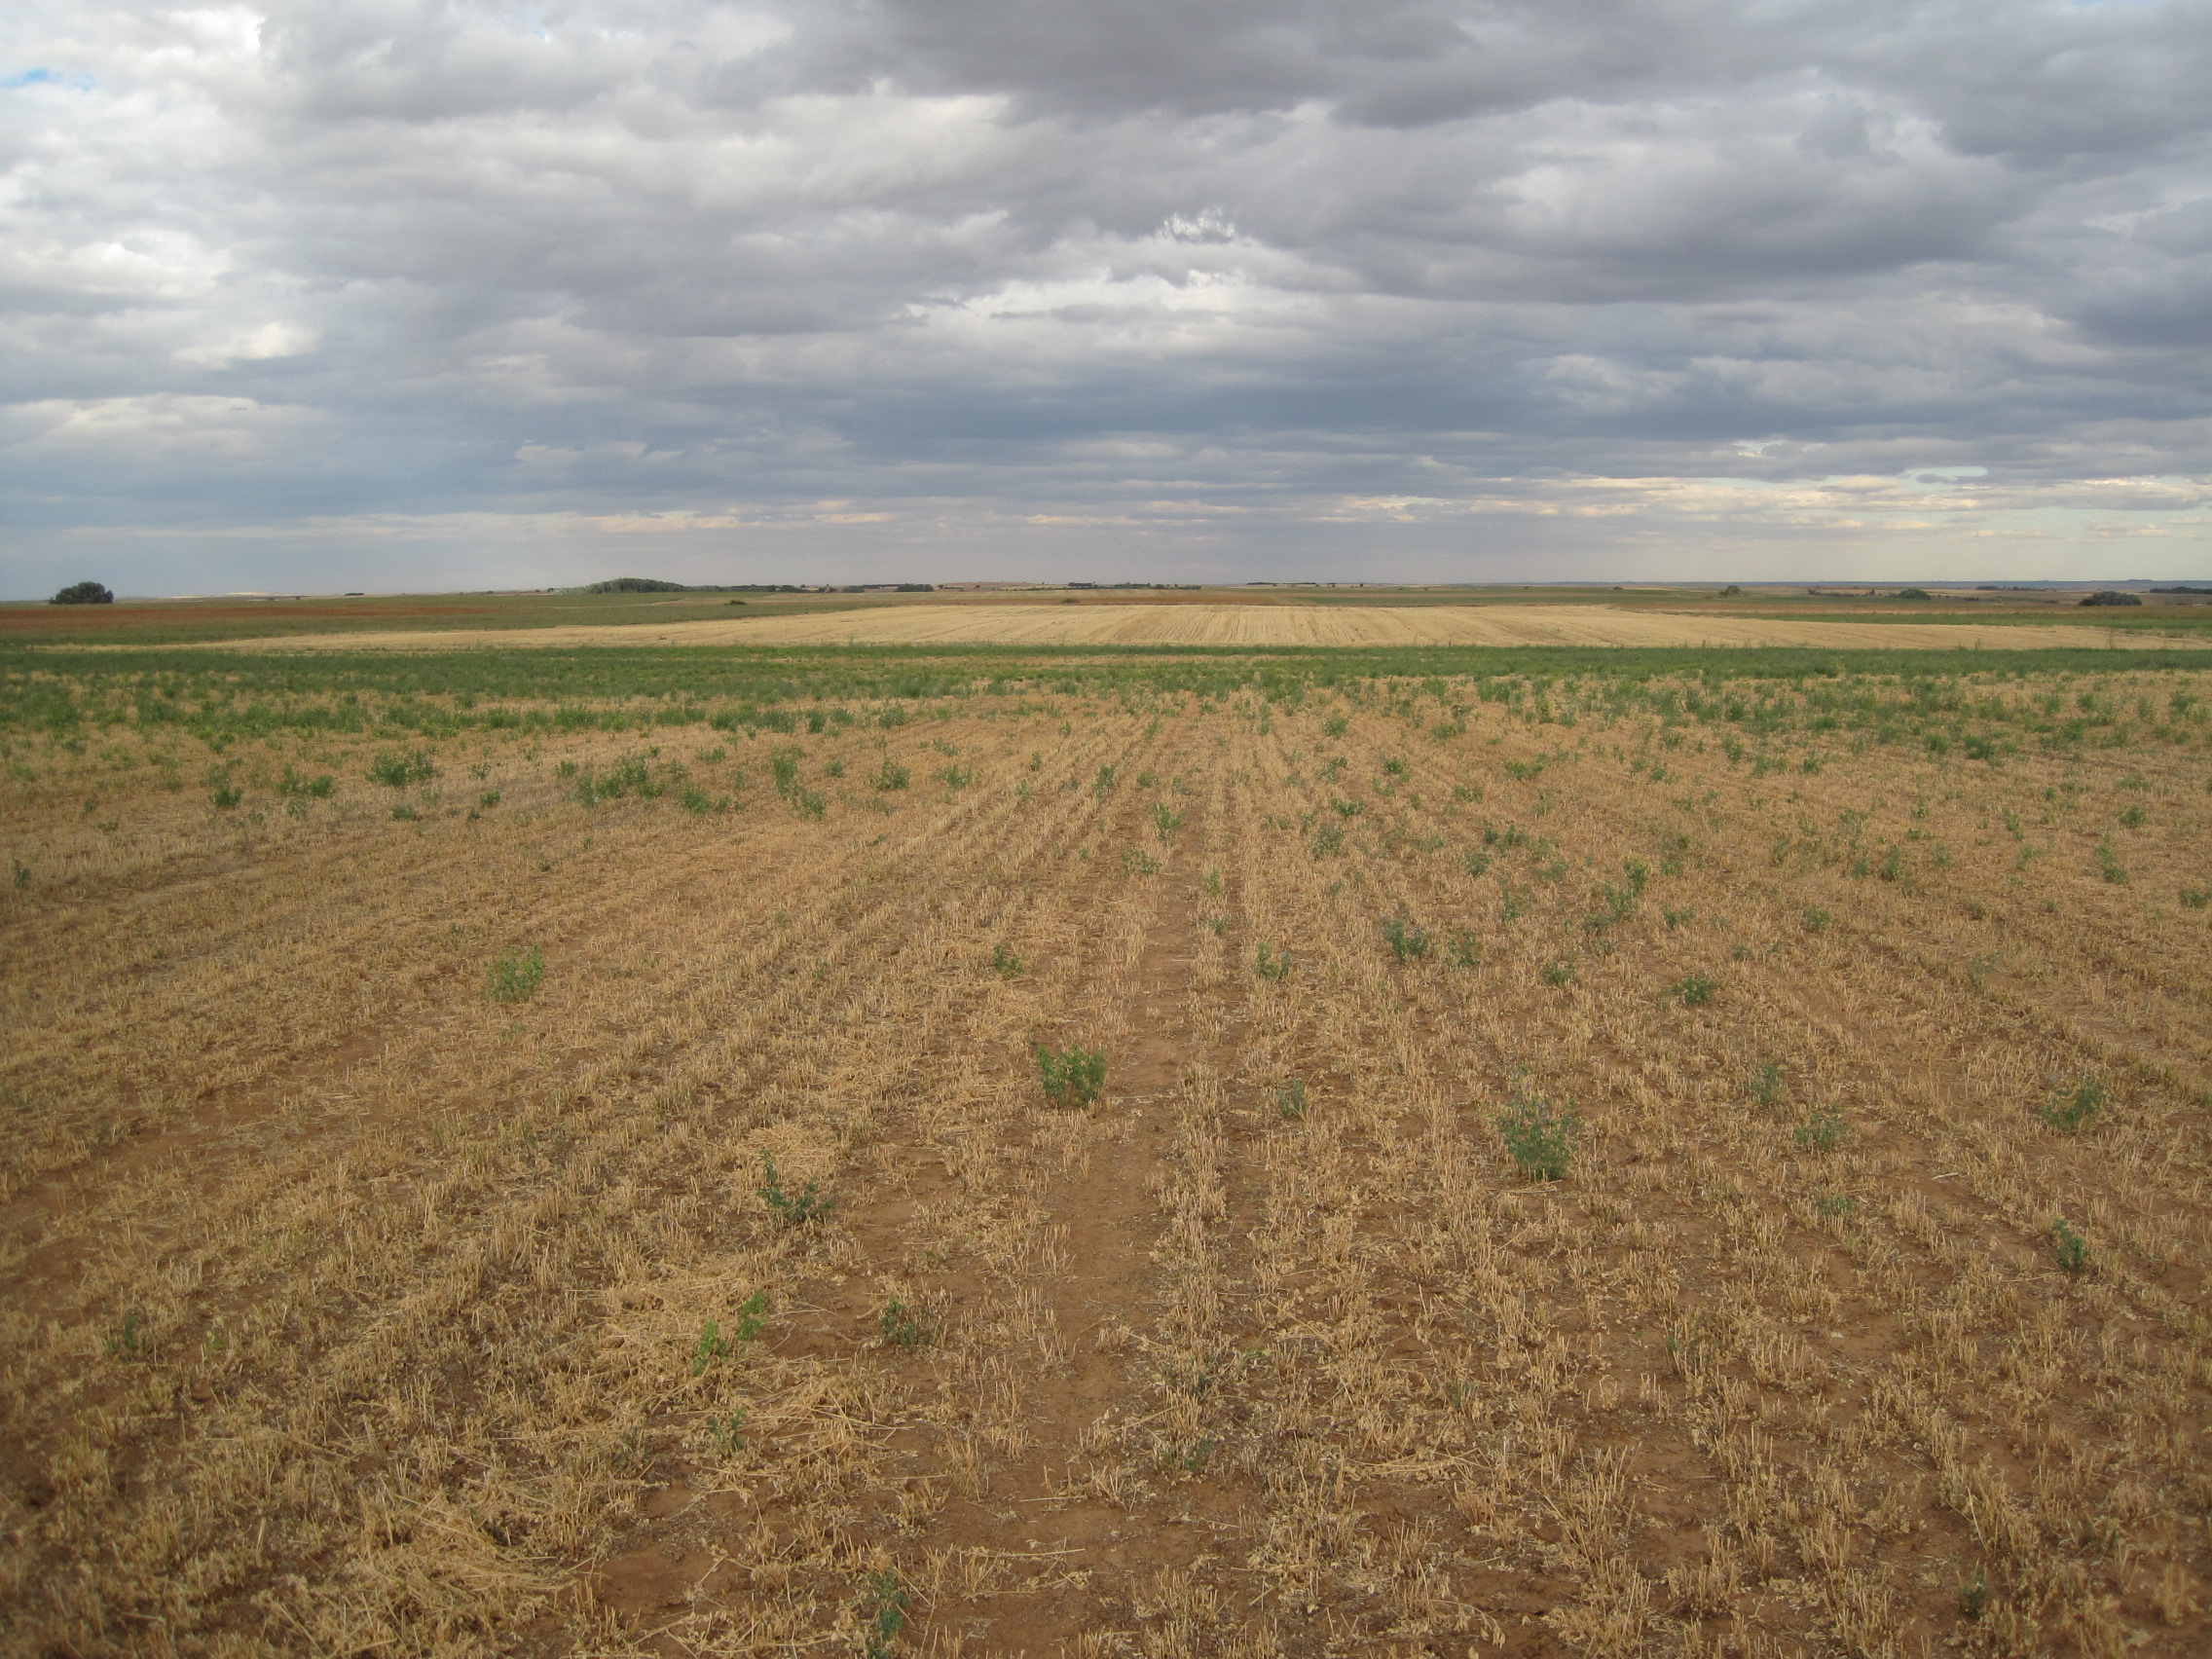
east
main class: Cropland
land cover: Lucerne
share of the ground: < 10 %
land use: Agriculture (excluding fallow land and kitchen gardens)
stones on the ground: 10 - 25 %
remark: Harvested field
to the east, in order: Lucerne; Grass margins; Barley
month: July
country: ES
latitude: 41.9390
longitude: -5.4402
